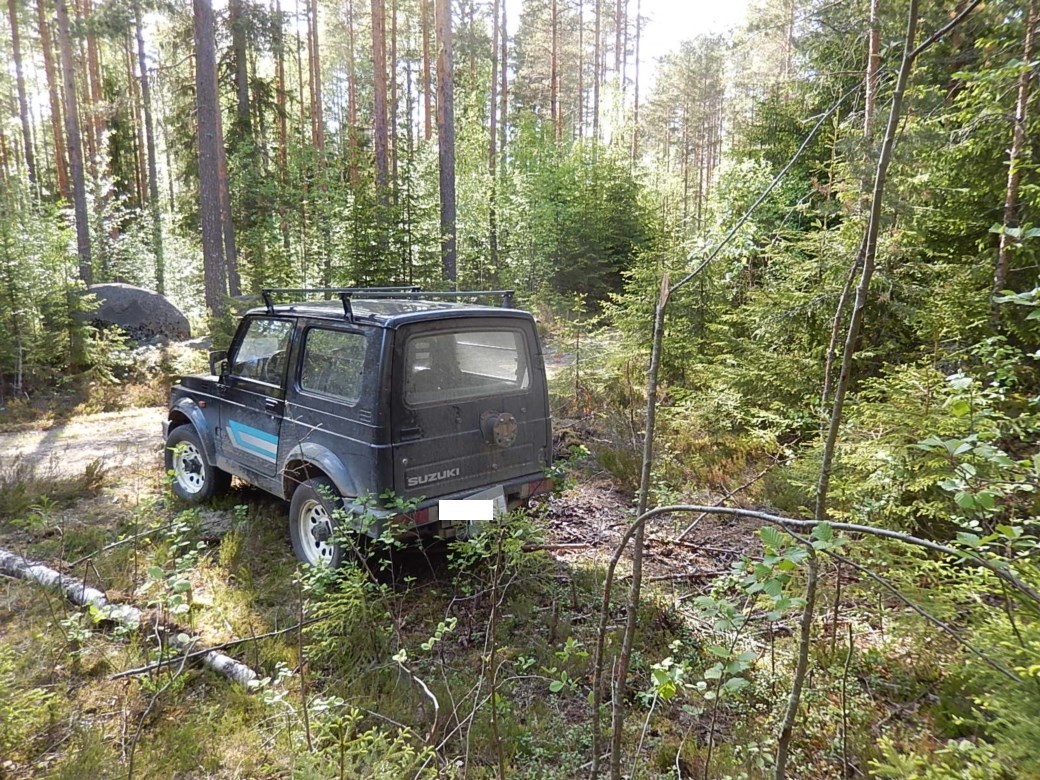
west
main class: Woodland
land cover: Pine dominated coniferous woodland
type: boreal forest
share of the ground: > 75 %
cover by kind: coniferous forest trees 75 %, shrubs 15 %, broadleaved forest trees 10 %
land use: Forestry
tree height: > 5 m
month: June
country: FI
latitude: 61.9050
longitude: 22.2968
